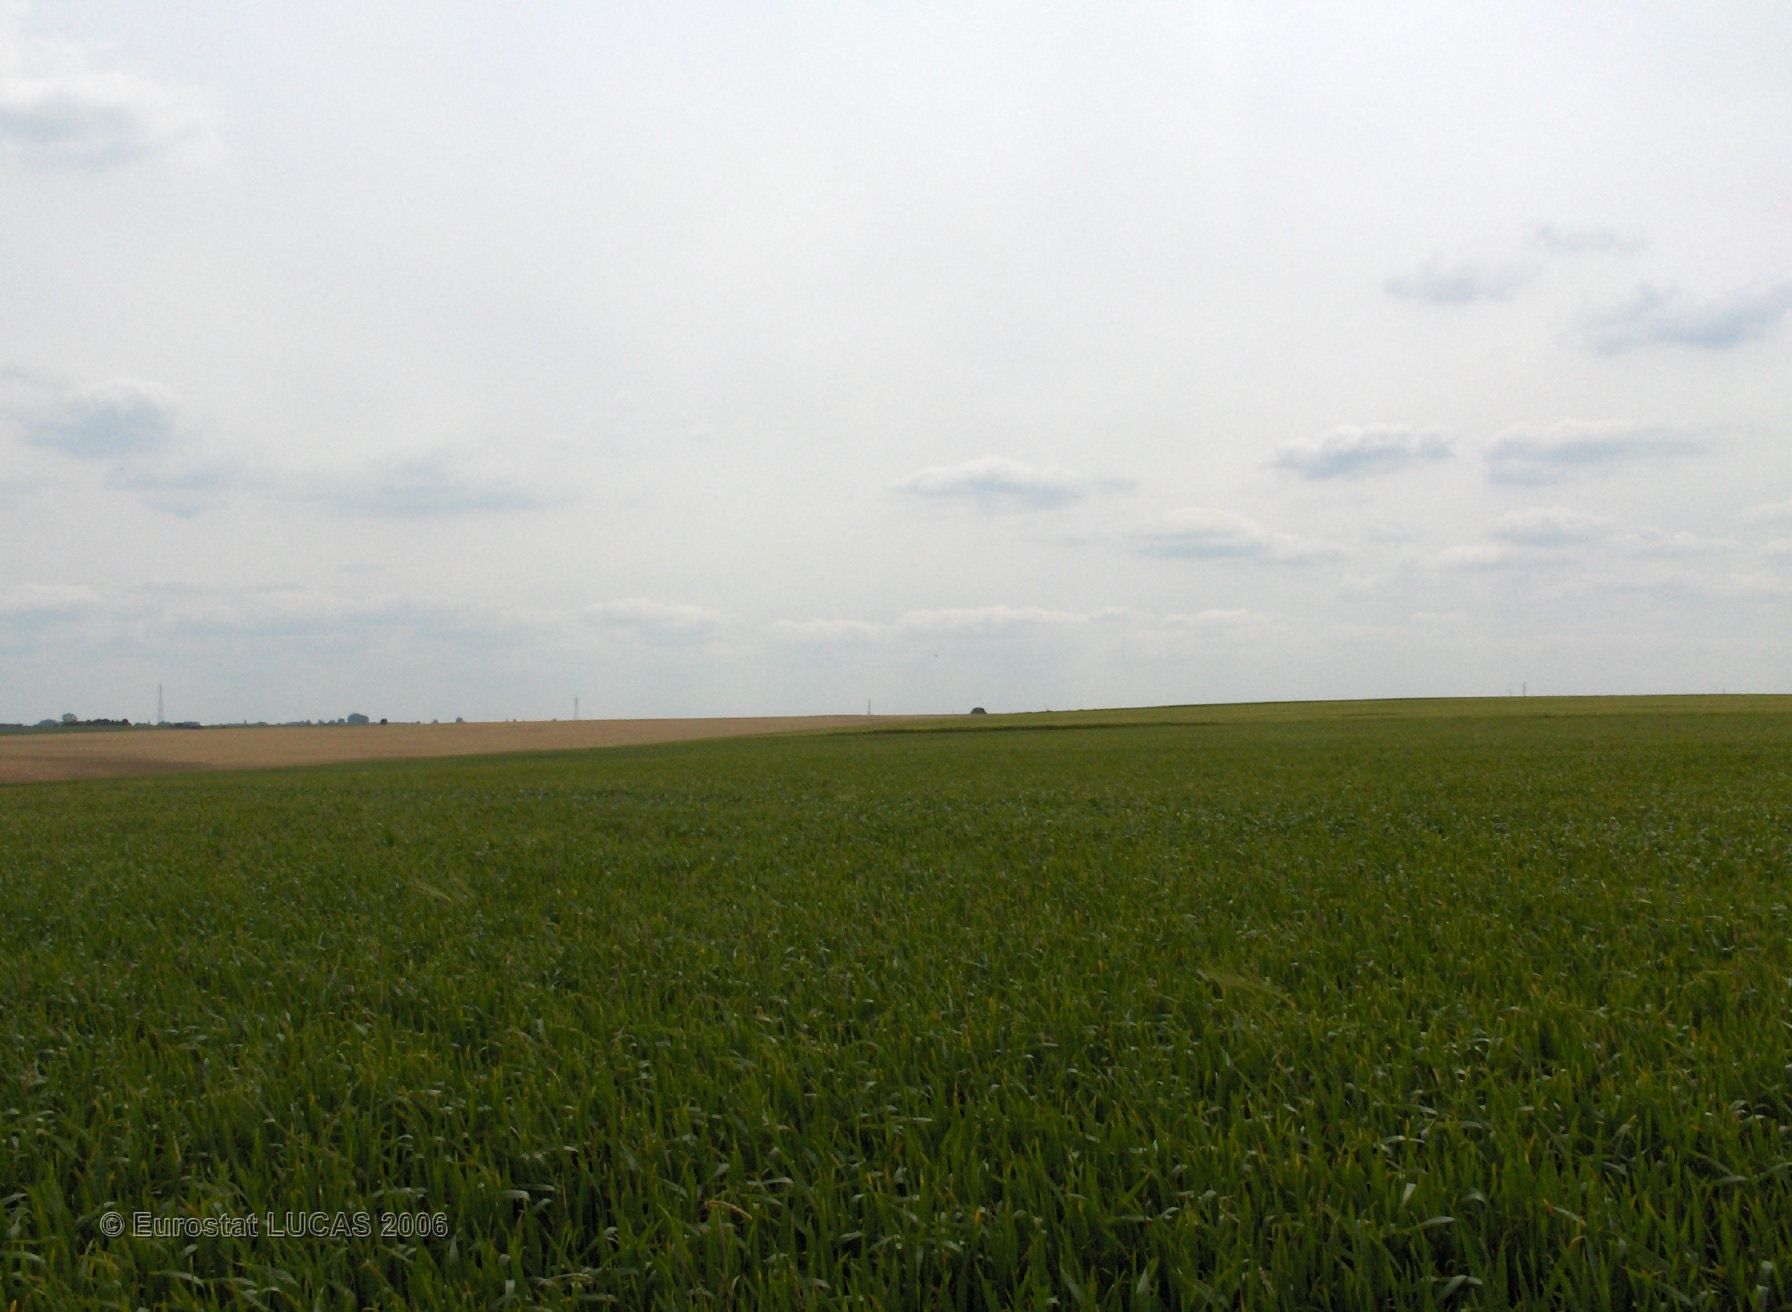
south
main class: Cropland
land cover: Common wheat
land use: Agriculture (excluding fallow land and kitchen gardens)
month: June
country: BE
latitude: 50.2338
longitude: 4.5425
